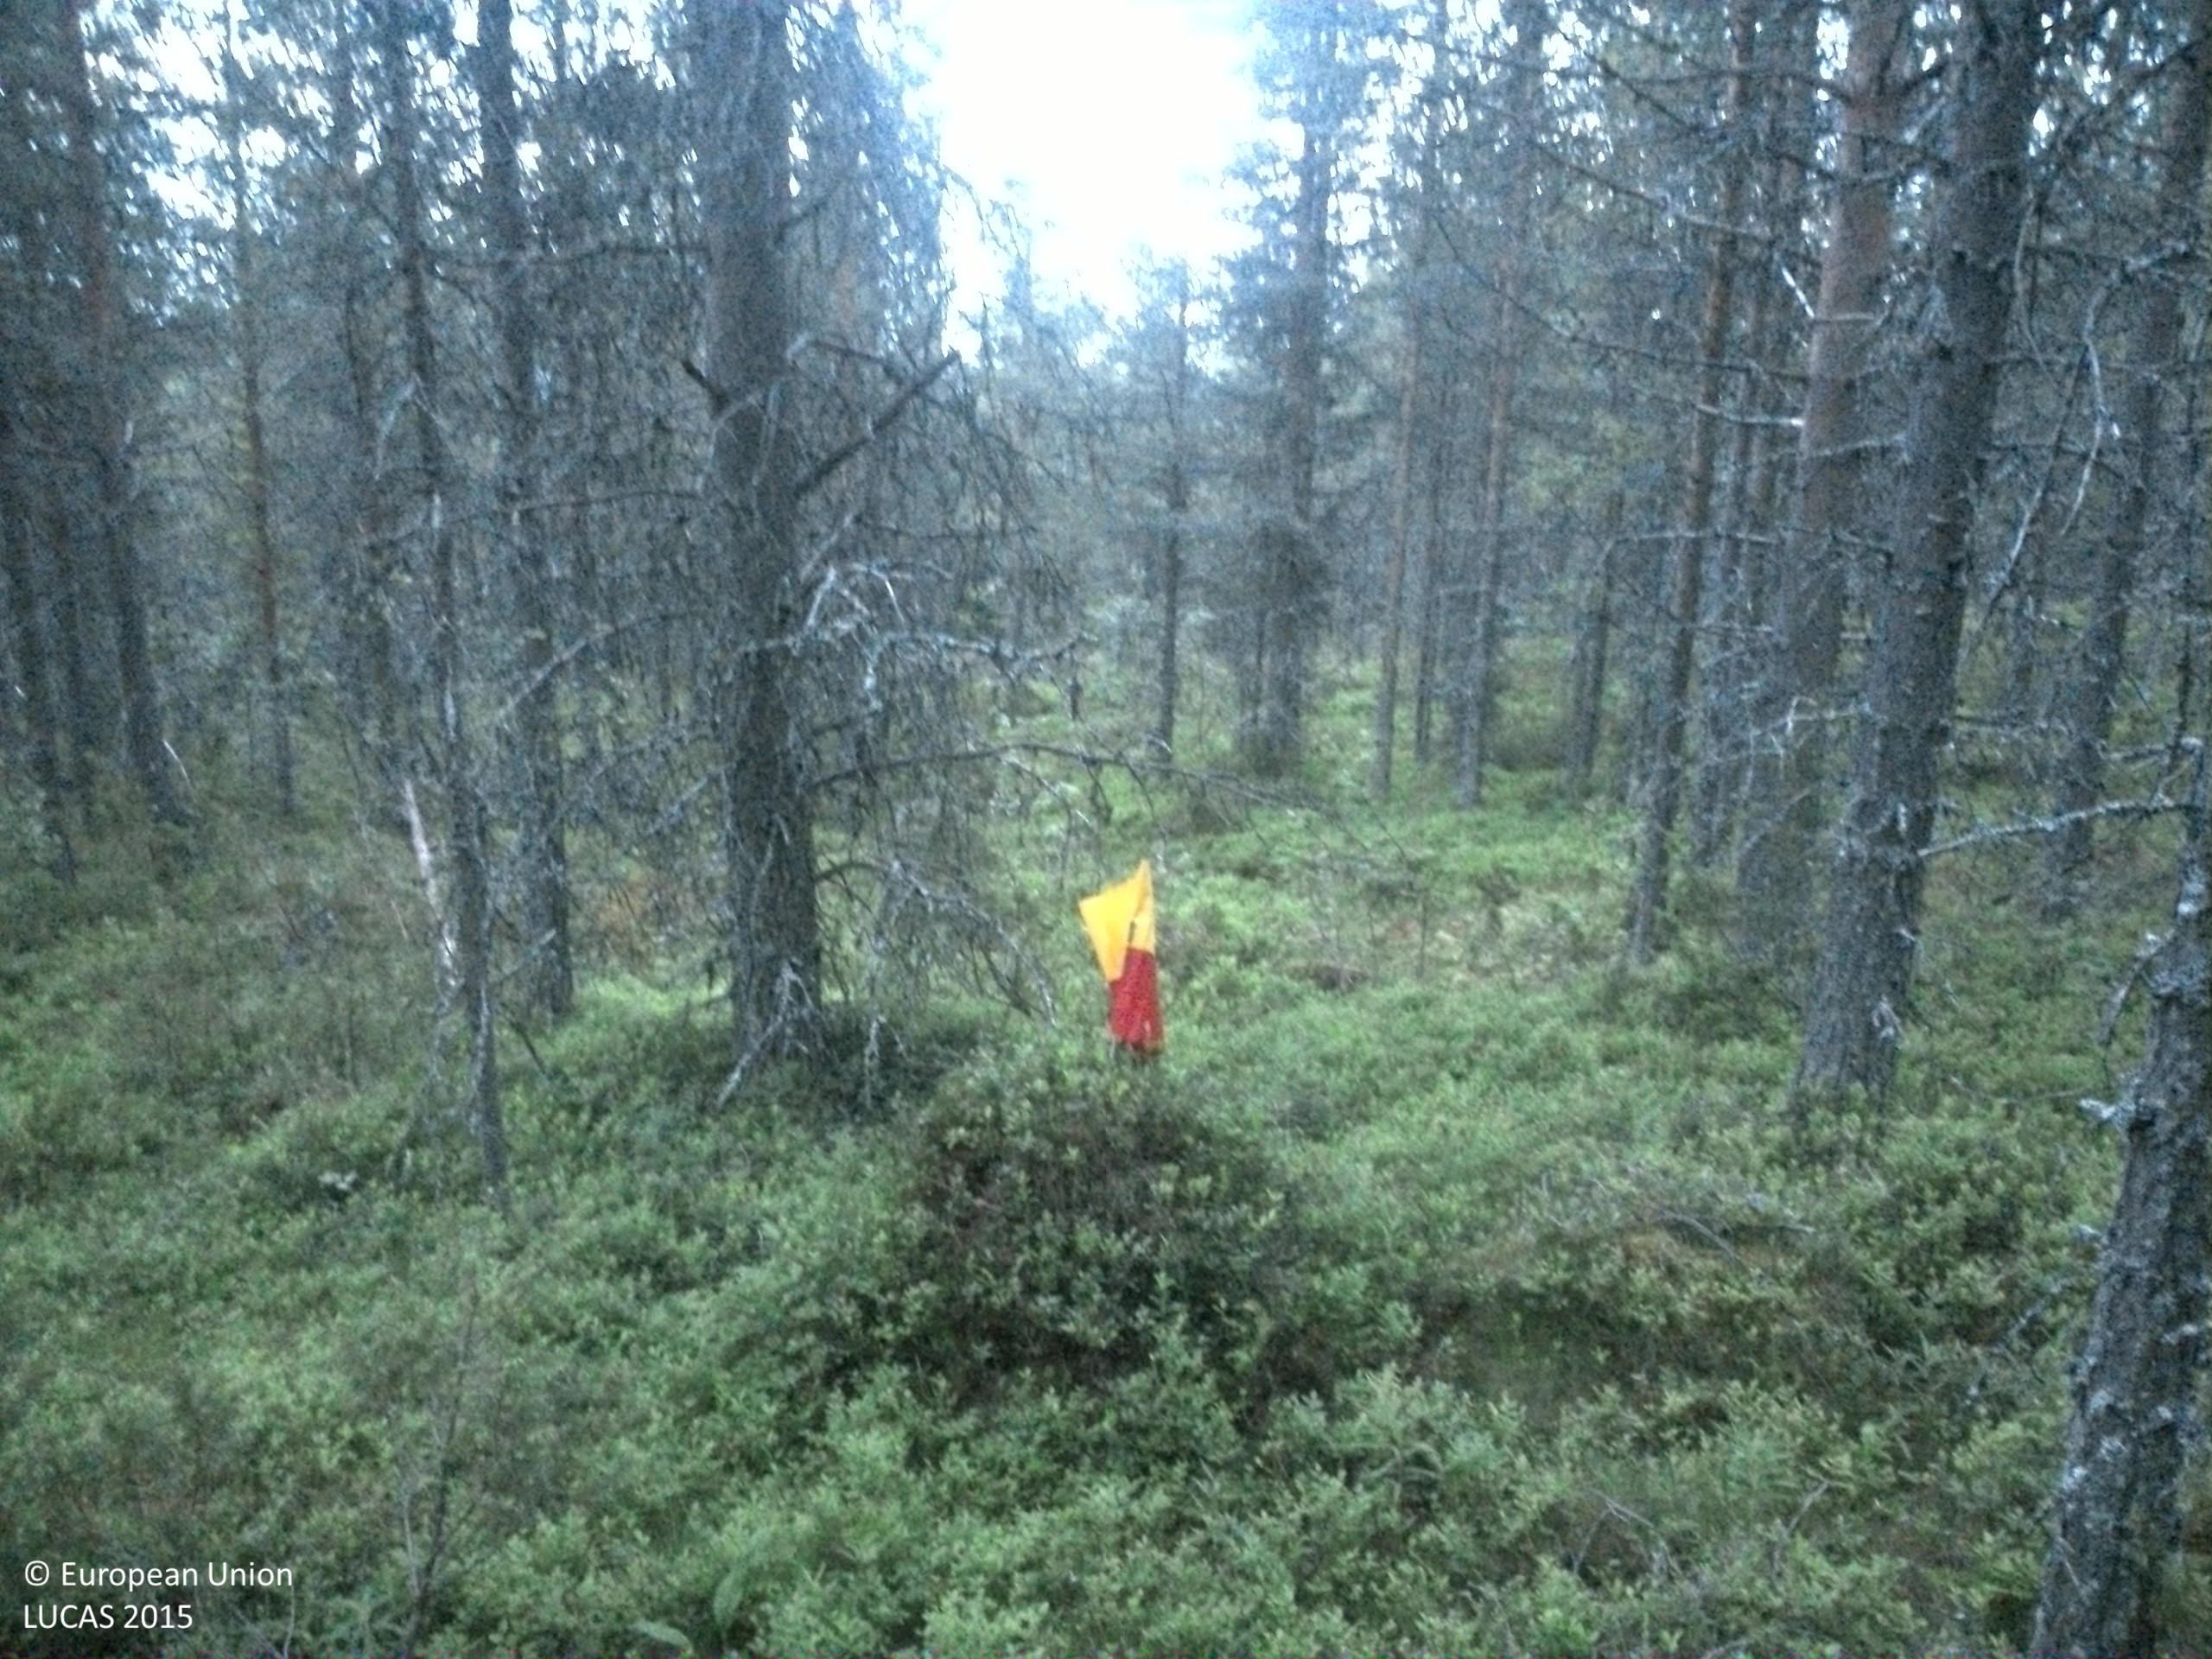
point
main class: Woodland
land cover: Pine dominated coniferous woodland
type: boreal forest
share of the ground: 50 - 75 %
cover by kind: coniferous forest trees 55 %, shrubs 35 %, broadleaved forest trees 5 %, herbaceous plants 5 %
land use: Forestry
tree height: > 5 m
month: July
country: SE
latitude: 64.2252
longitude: 16.5858
